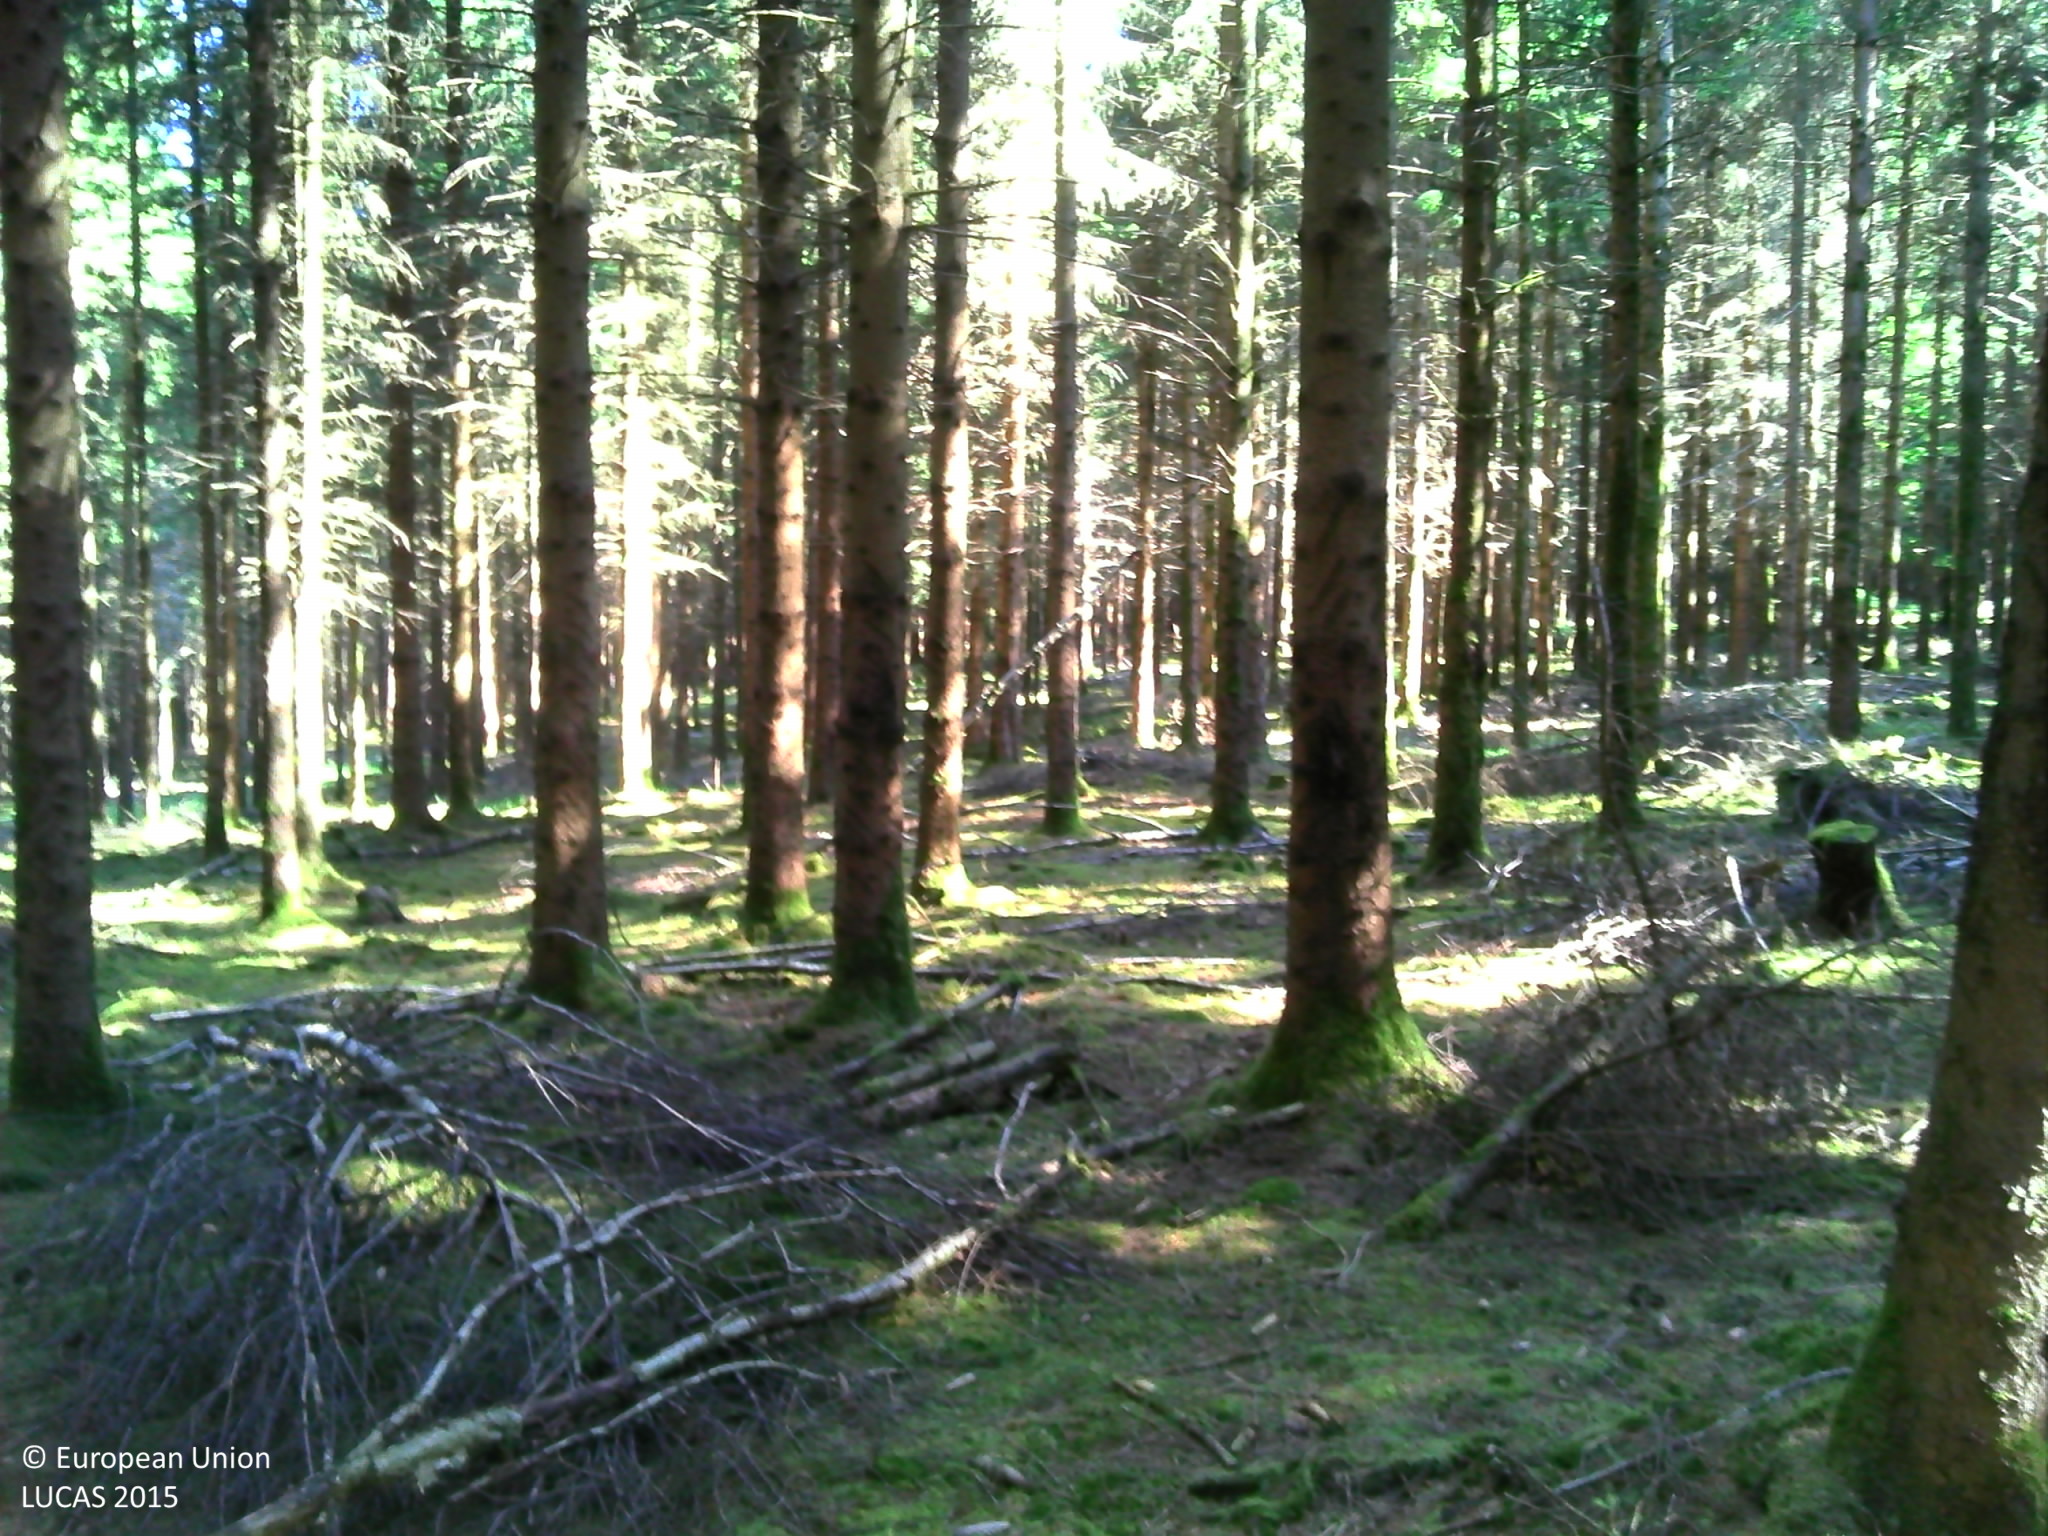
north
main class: Woodland
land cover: Spruce dominated coniferous woodland
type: alpine coniferous forest
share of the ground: > 75 %
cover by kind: coniferous forest trees 95 %, lichens and mosses 5 %
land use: Forestry
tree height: > 5 m
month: July
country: BE
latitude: 50.1773
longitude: 5.7558
